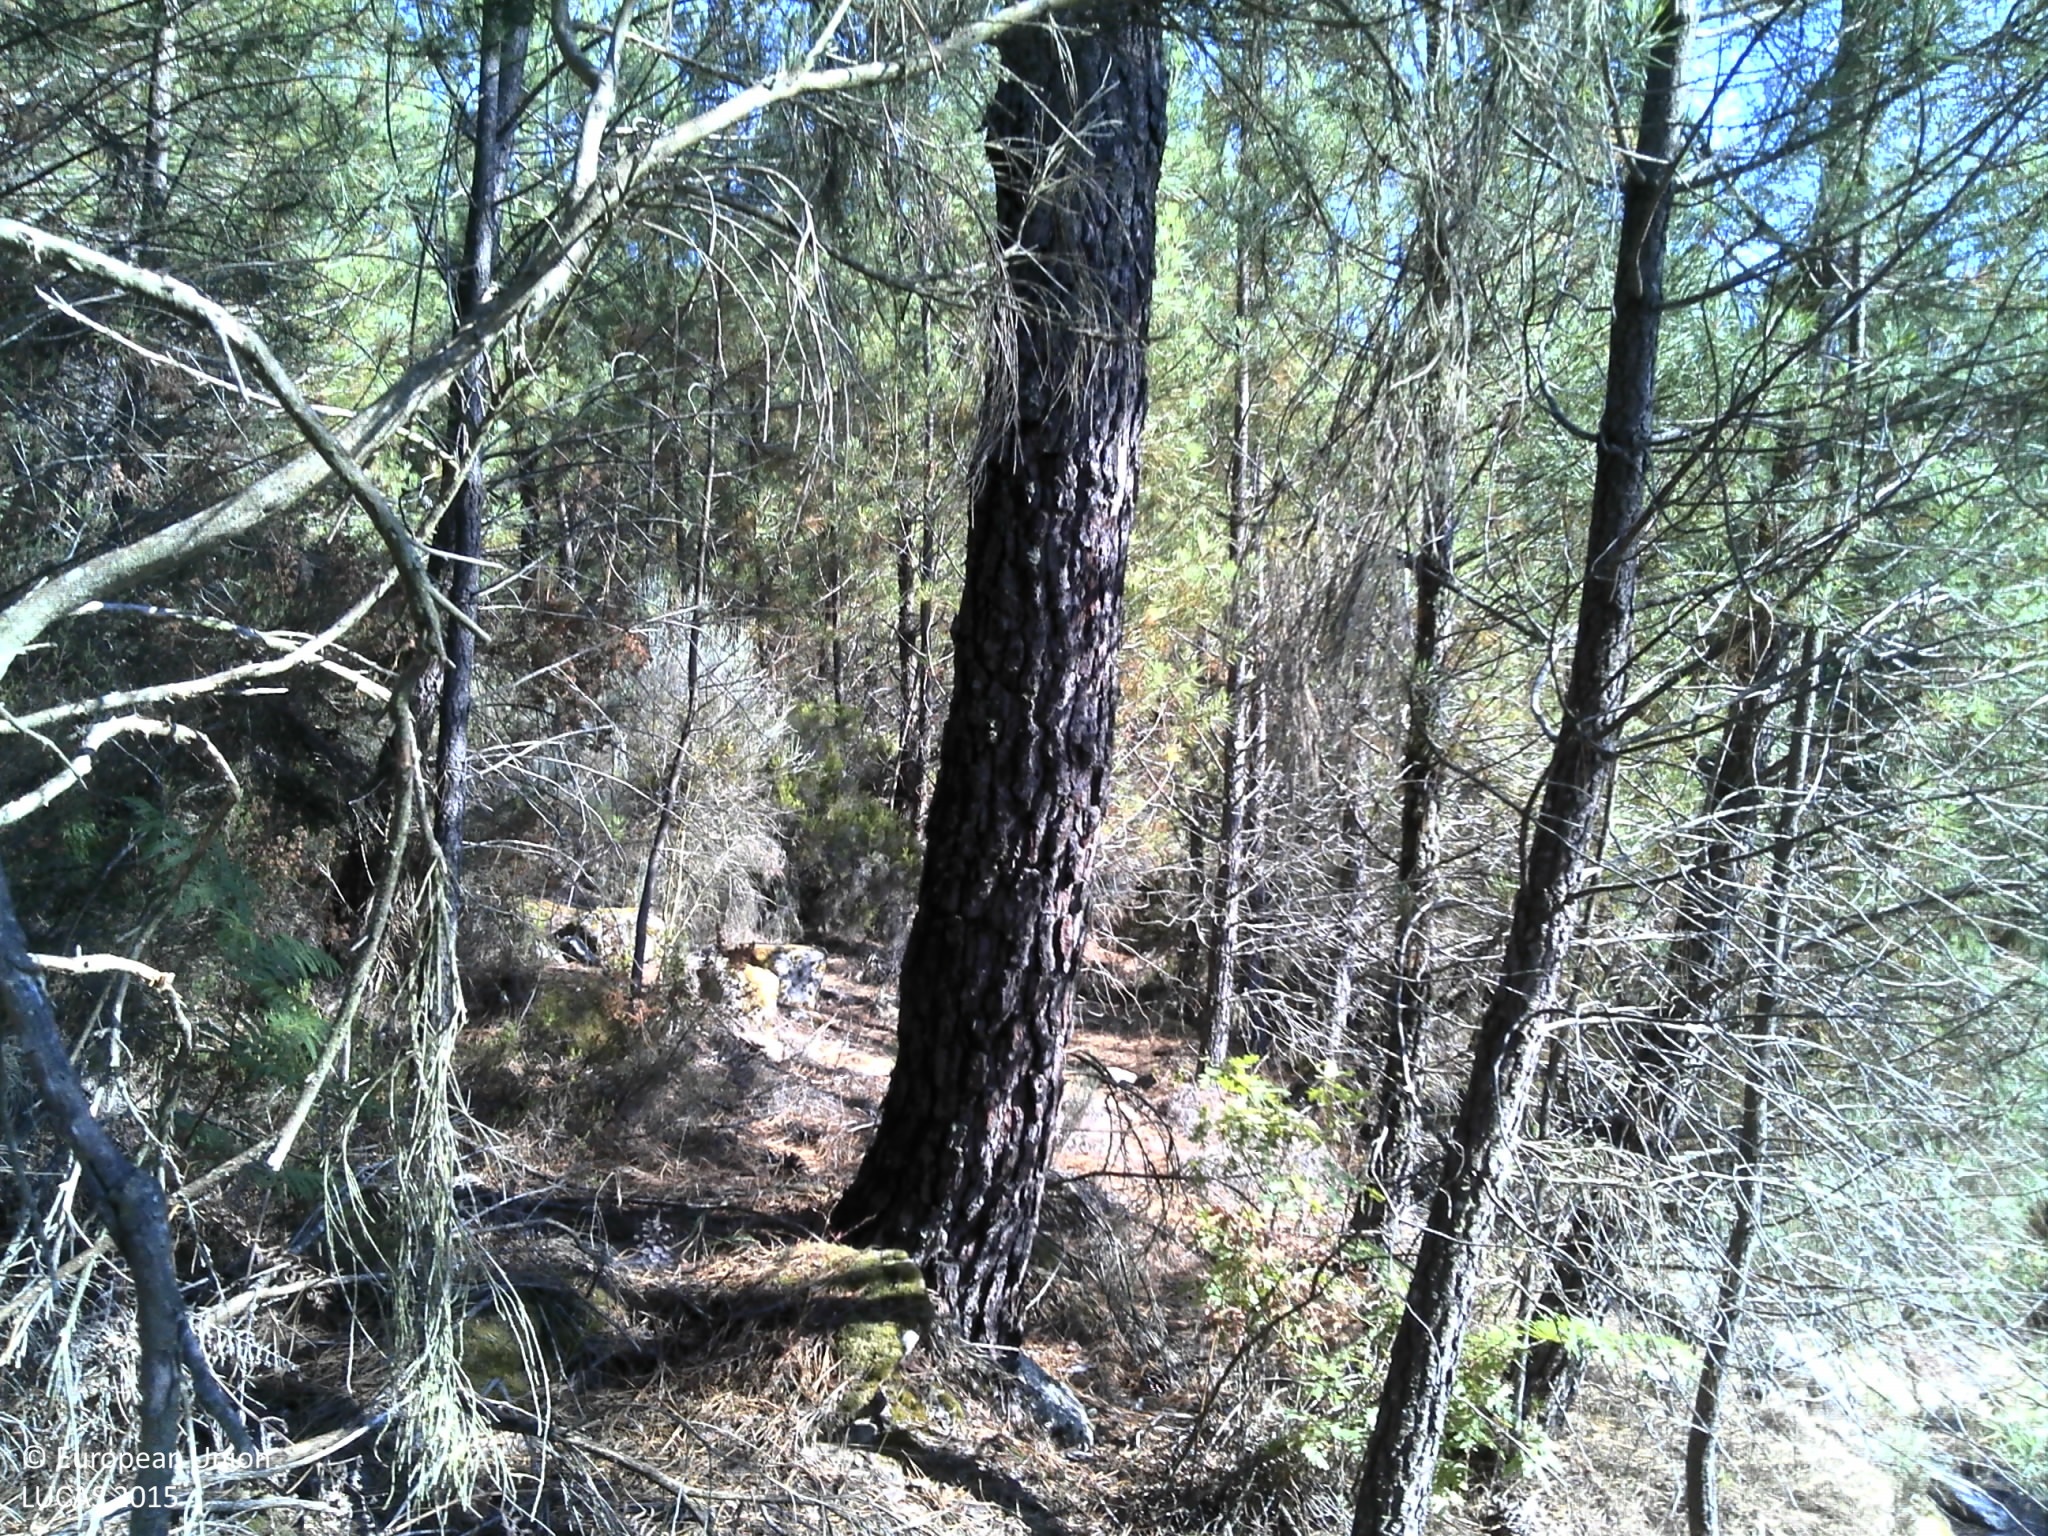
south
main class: Woodland
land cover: Pine dominated coniferous woodland
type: coniferous forest of the mediterranean region
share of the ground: 10 - 25 %
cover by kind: shrubs 80 %, coniferous forest trees 15 %, consolidated bare surface 5 %
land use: Forestry
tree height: > 5 m
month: July
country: PT
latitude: 40.7753
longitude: -7.4484
